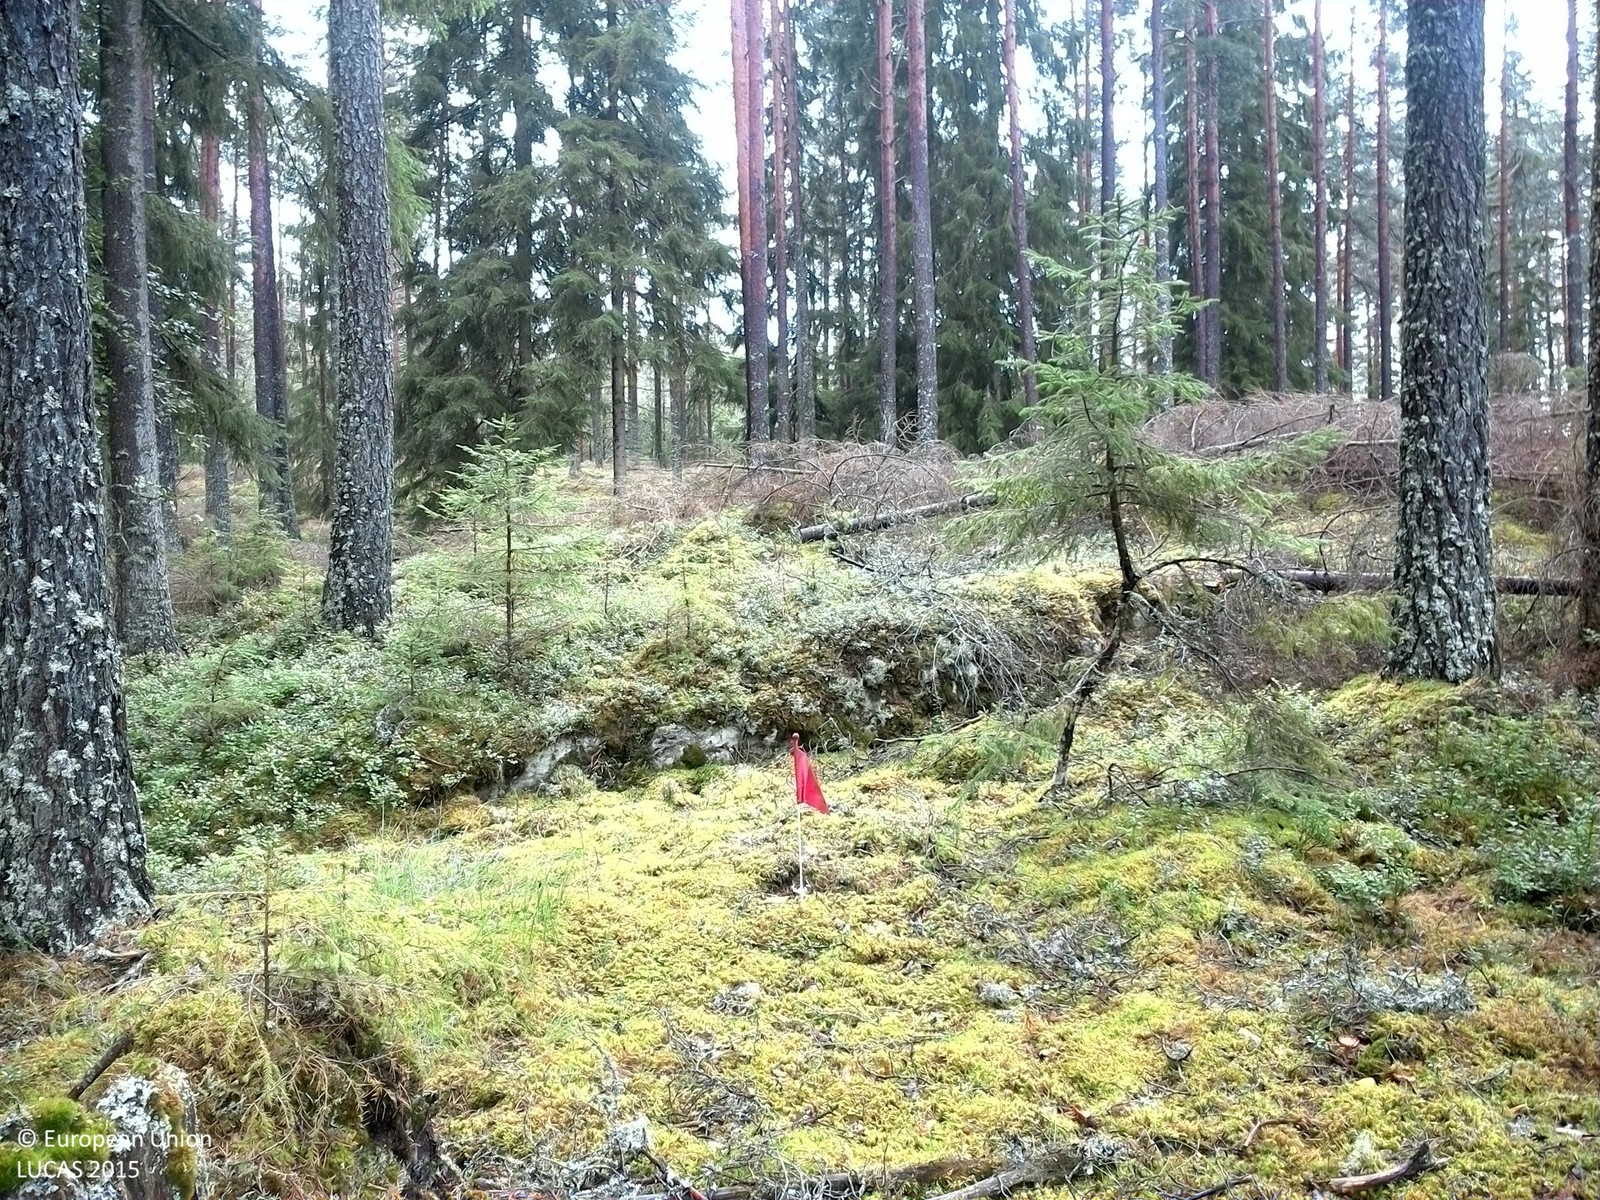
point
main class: Woodland
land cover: Pine dominated coniferous woodland
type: boreal forest
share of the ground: 50 - 75 %
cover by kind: coniferous forest trees 65 %, lichens and mosses 20 %, shrubs 10 %, broadleaved forest trees 5 %
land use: Forestry
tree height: > 5 m
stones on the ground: < 10 %
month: September
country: SE
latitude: 59.2656
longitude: 12.0474
